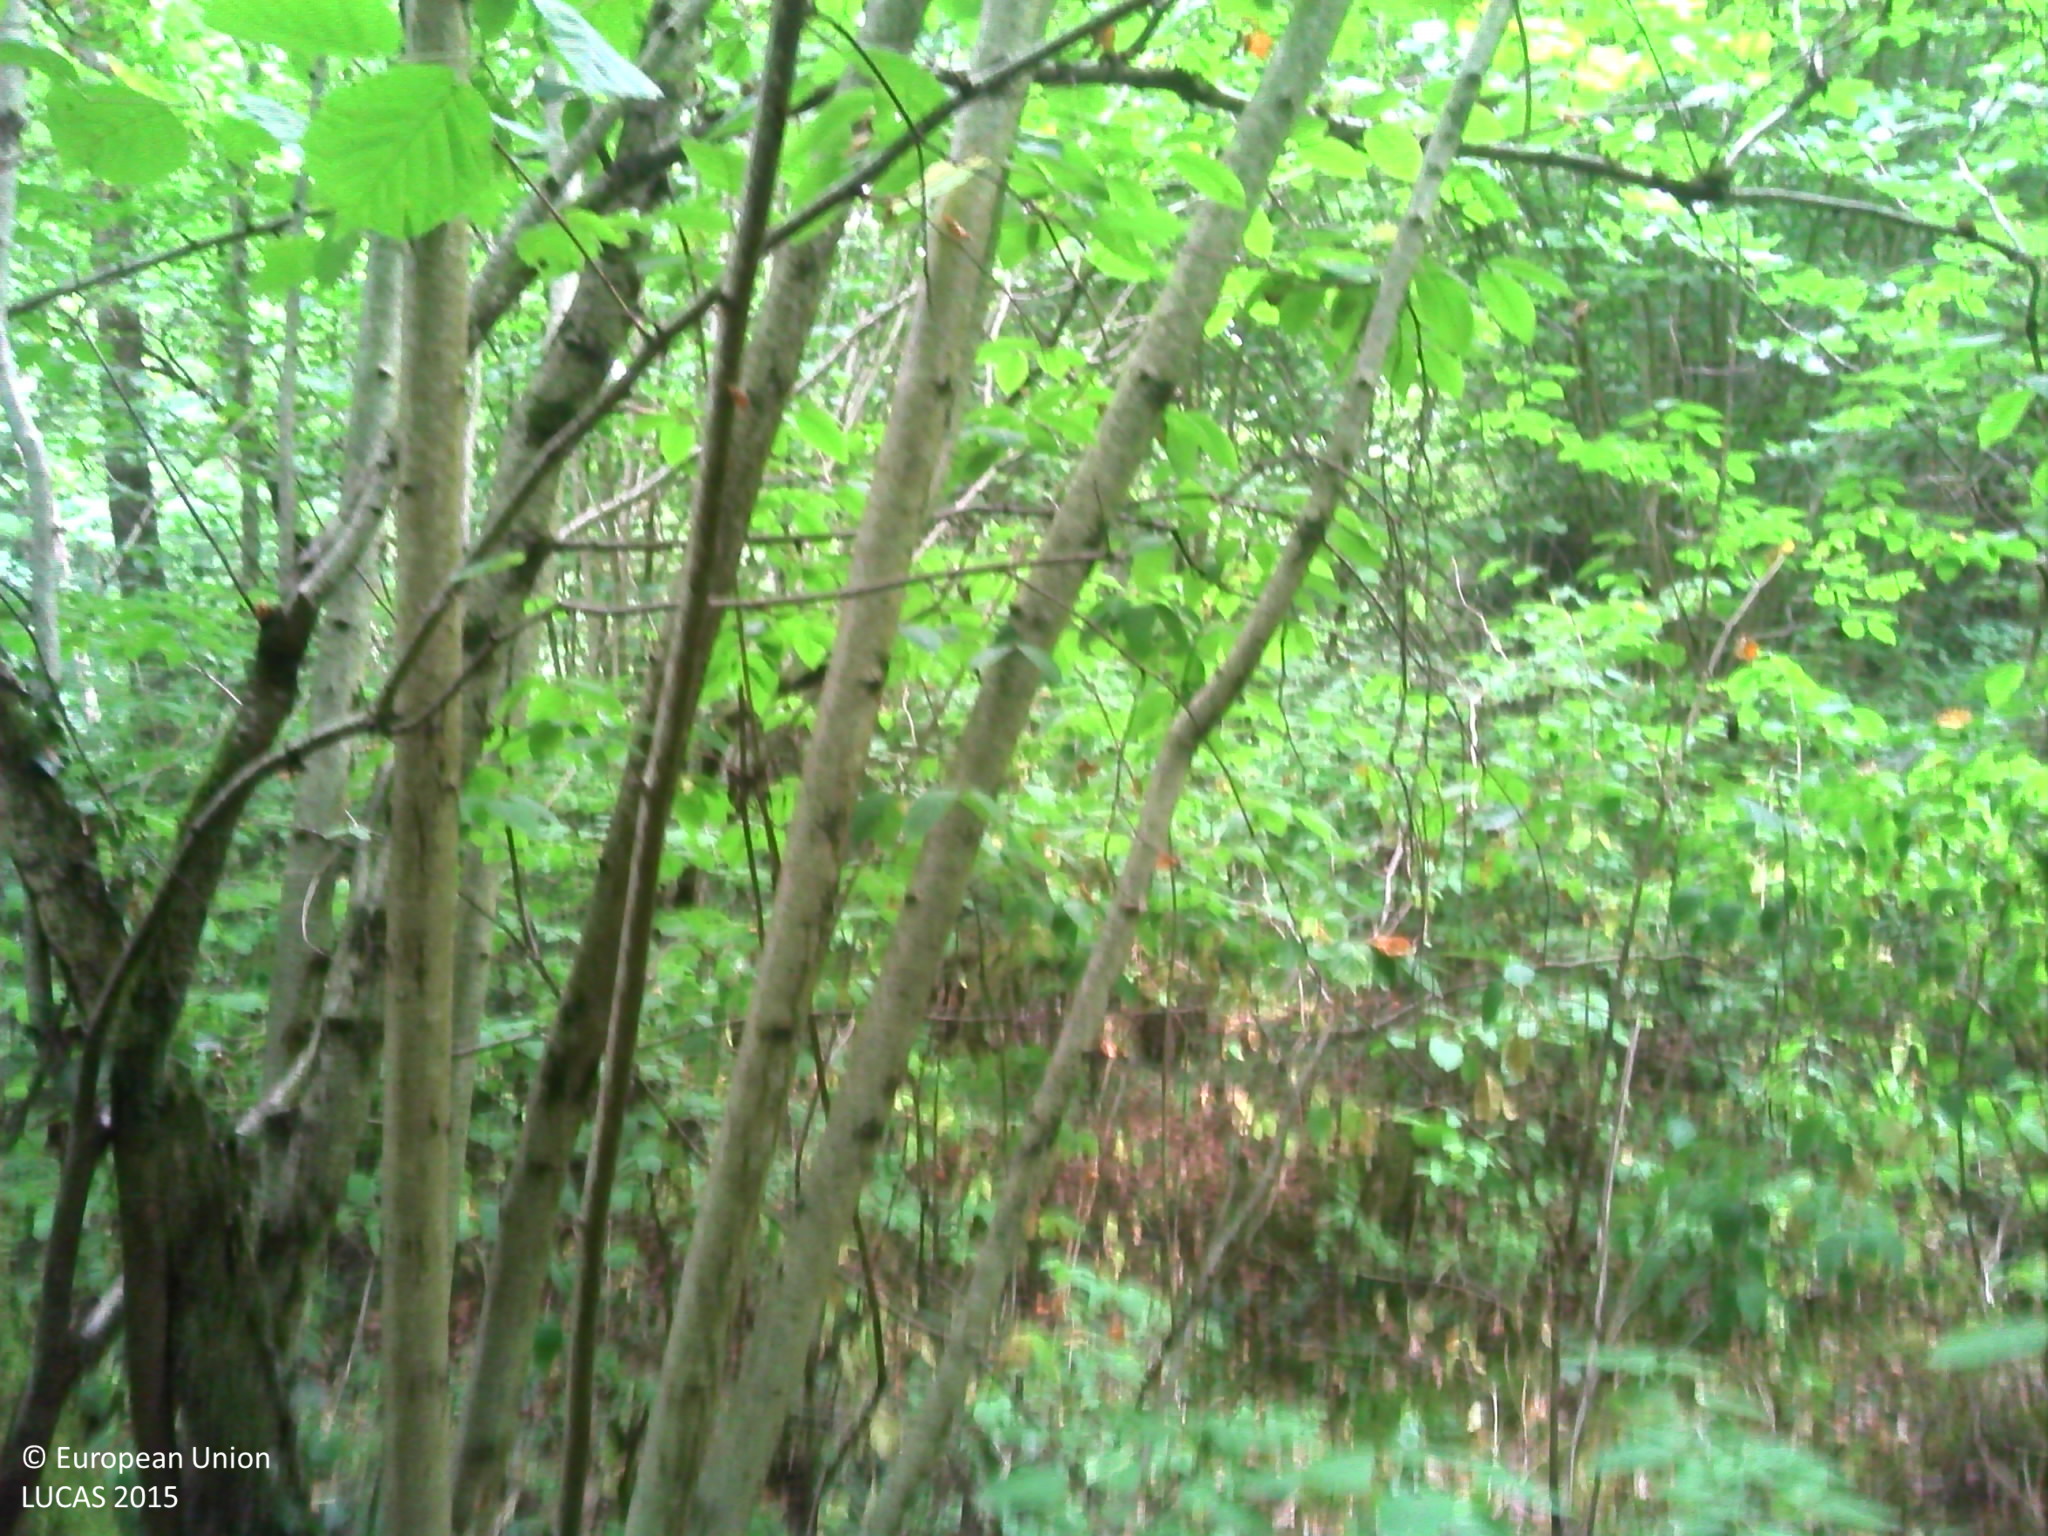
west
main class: Woodland
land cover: Broadleaved woodland
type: acidophilous oak and oak-birch forest
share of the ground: > 75 %
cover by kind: broadleaved forest trees 80 %, herbaceous plants 10 %, coniferous forest trees 5 %, lichens and mosses 5 %
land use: Forestry
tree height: > 5 m
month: July
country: FR
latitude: 48.0450
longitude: 5.1568
